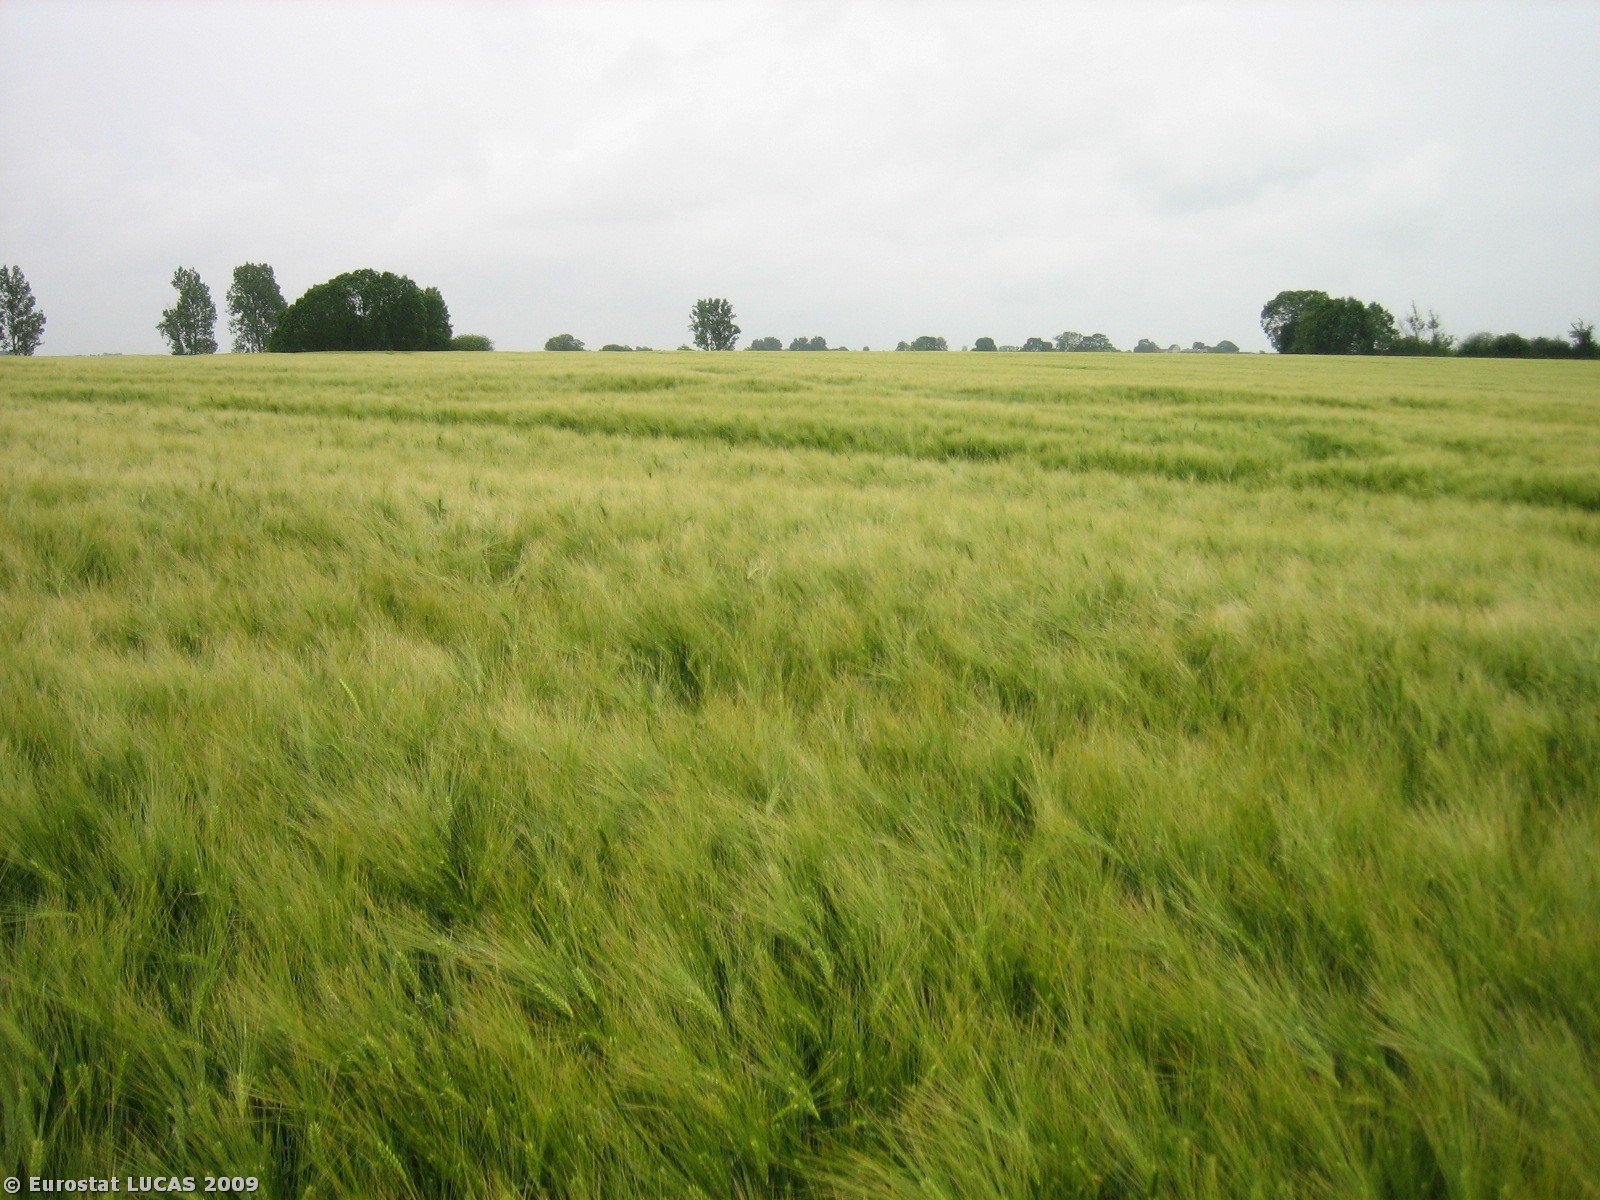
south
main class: Cropland
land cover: Barley
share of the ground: > 75 %
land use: Agriculture (excluding fallow land and kitchen gardens)
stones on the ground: < 10 %
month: June
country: DK
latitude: 55.9180
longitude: 10.1758
